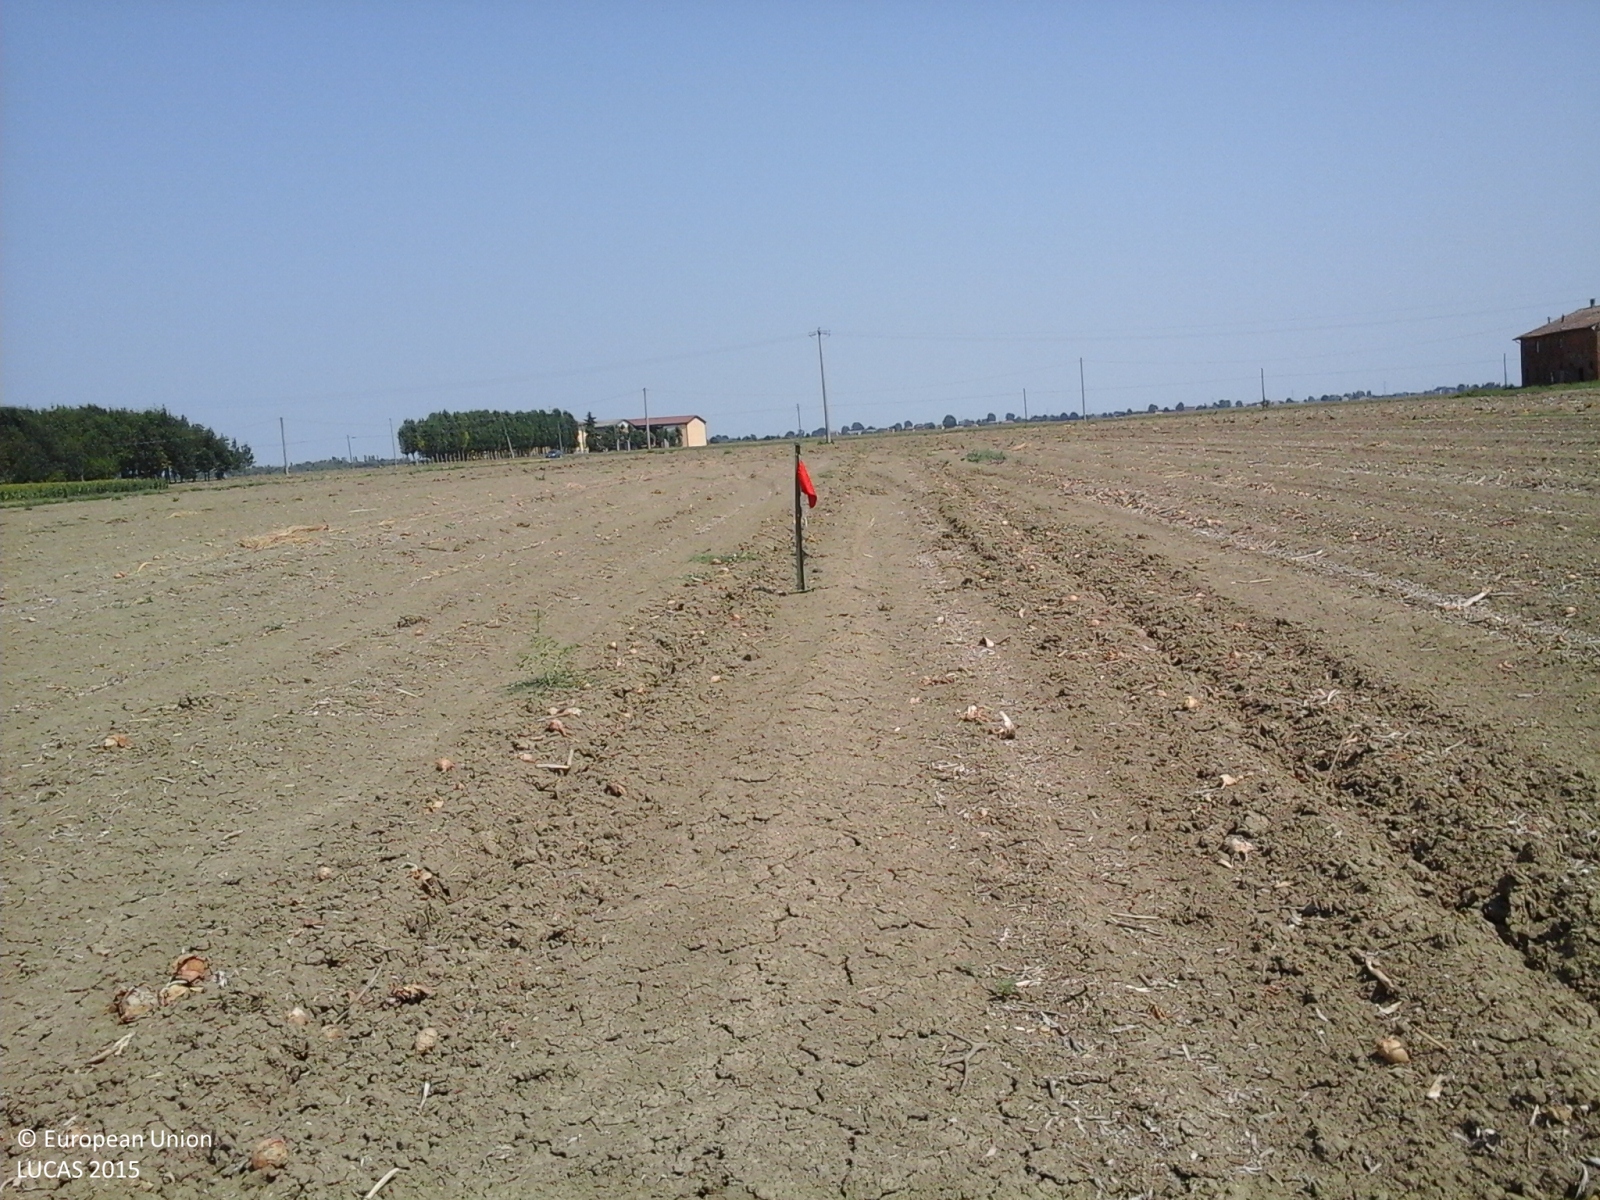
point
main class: Cropland
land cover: Other root crops
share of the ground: > 75 %
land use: Agriculture (excluding fallow land and kitchen gardens)
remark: Harvested field
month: July
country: IT
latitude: 44.4991
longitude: 11.6942
